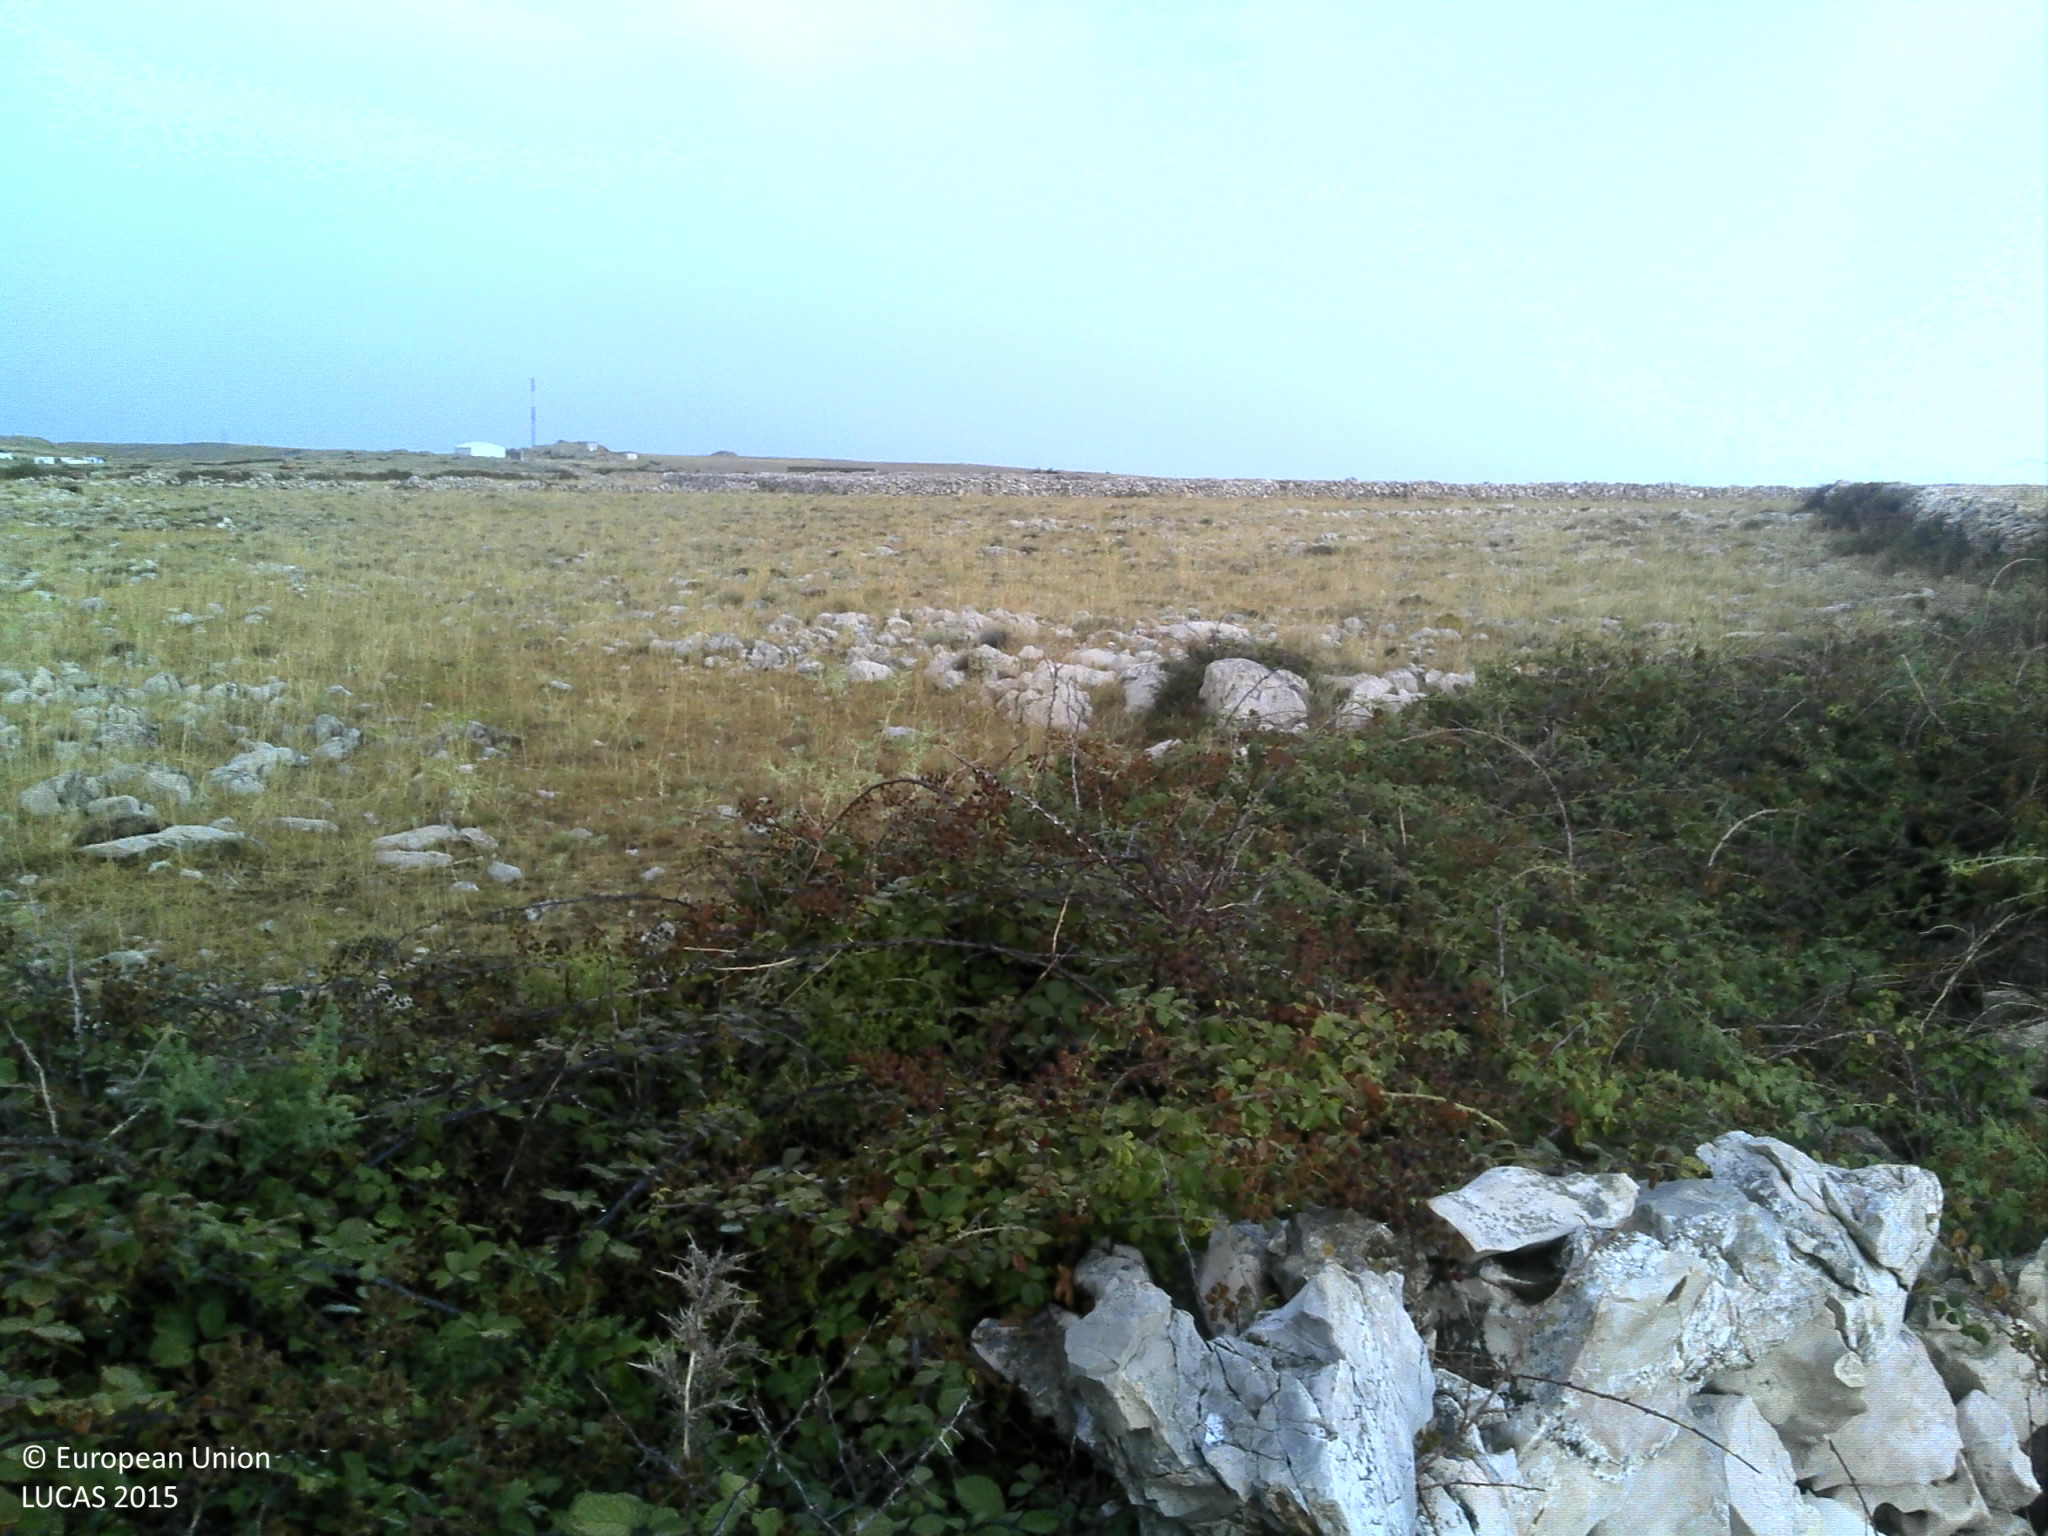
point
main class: Grassland
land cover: Grassland without tree/shrub cover
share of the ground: 50 - 75 %
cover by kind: herbaceous plants 50 %, unconsolidated bare surface 45 %, shrubs 5 %
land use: Agriculture (excluding fallow land and kitchen gardens)
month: July
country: HR
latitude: 44.3505
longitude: 15.1235
